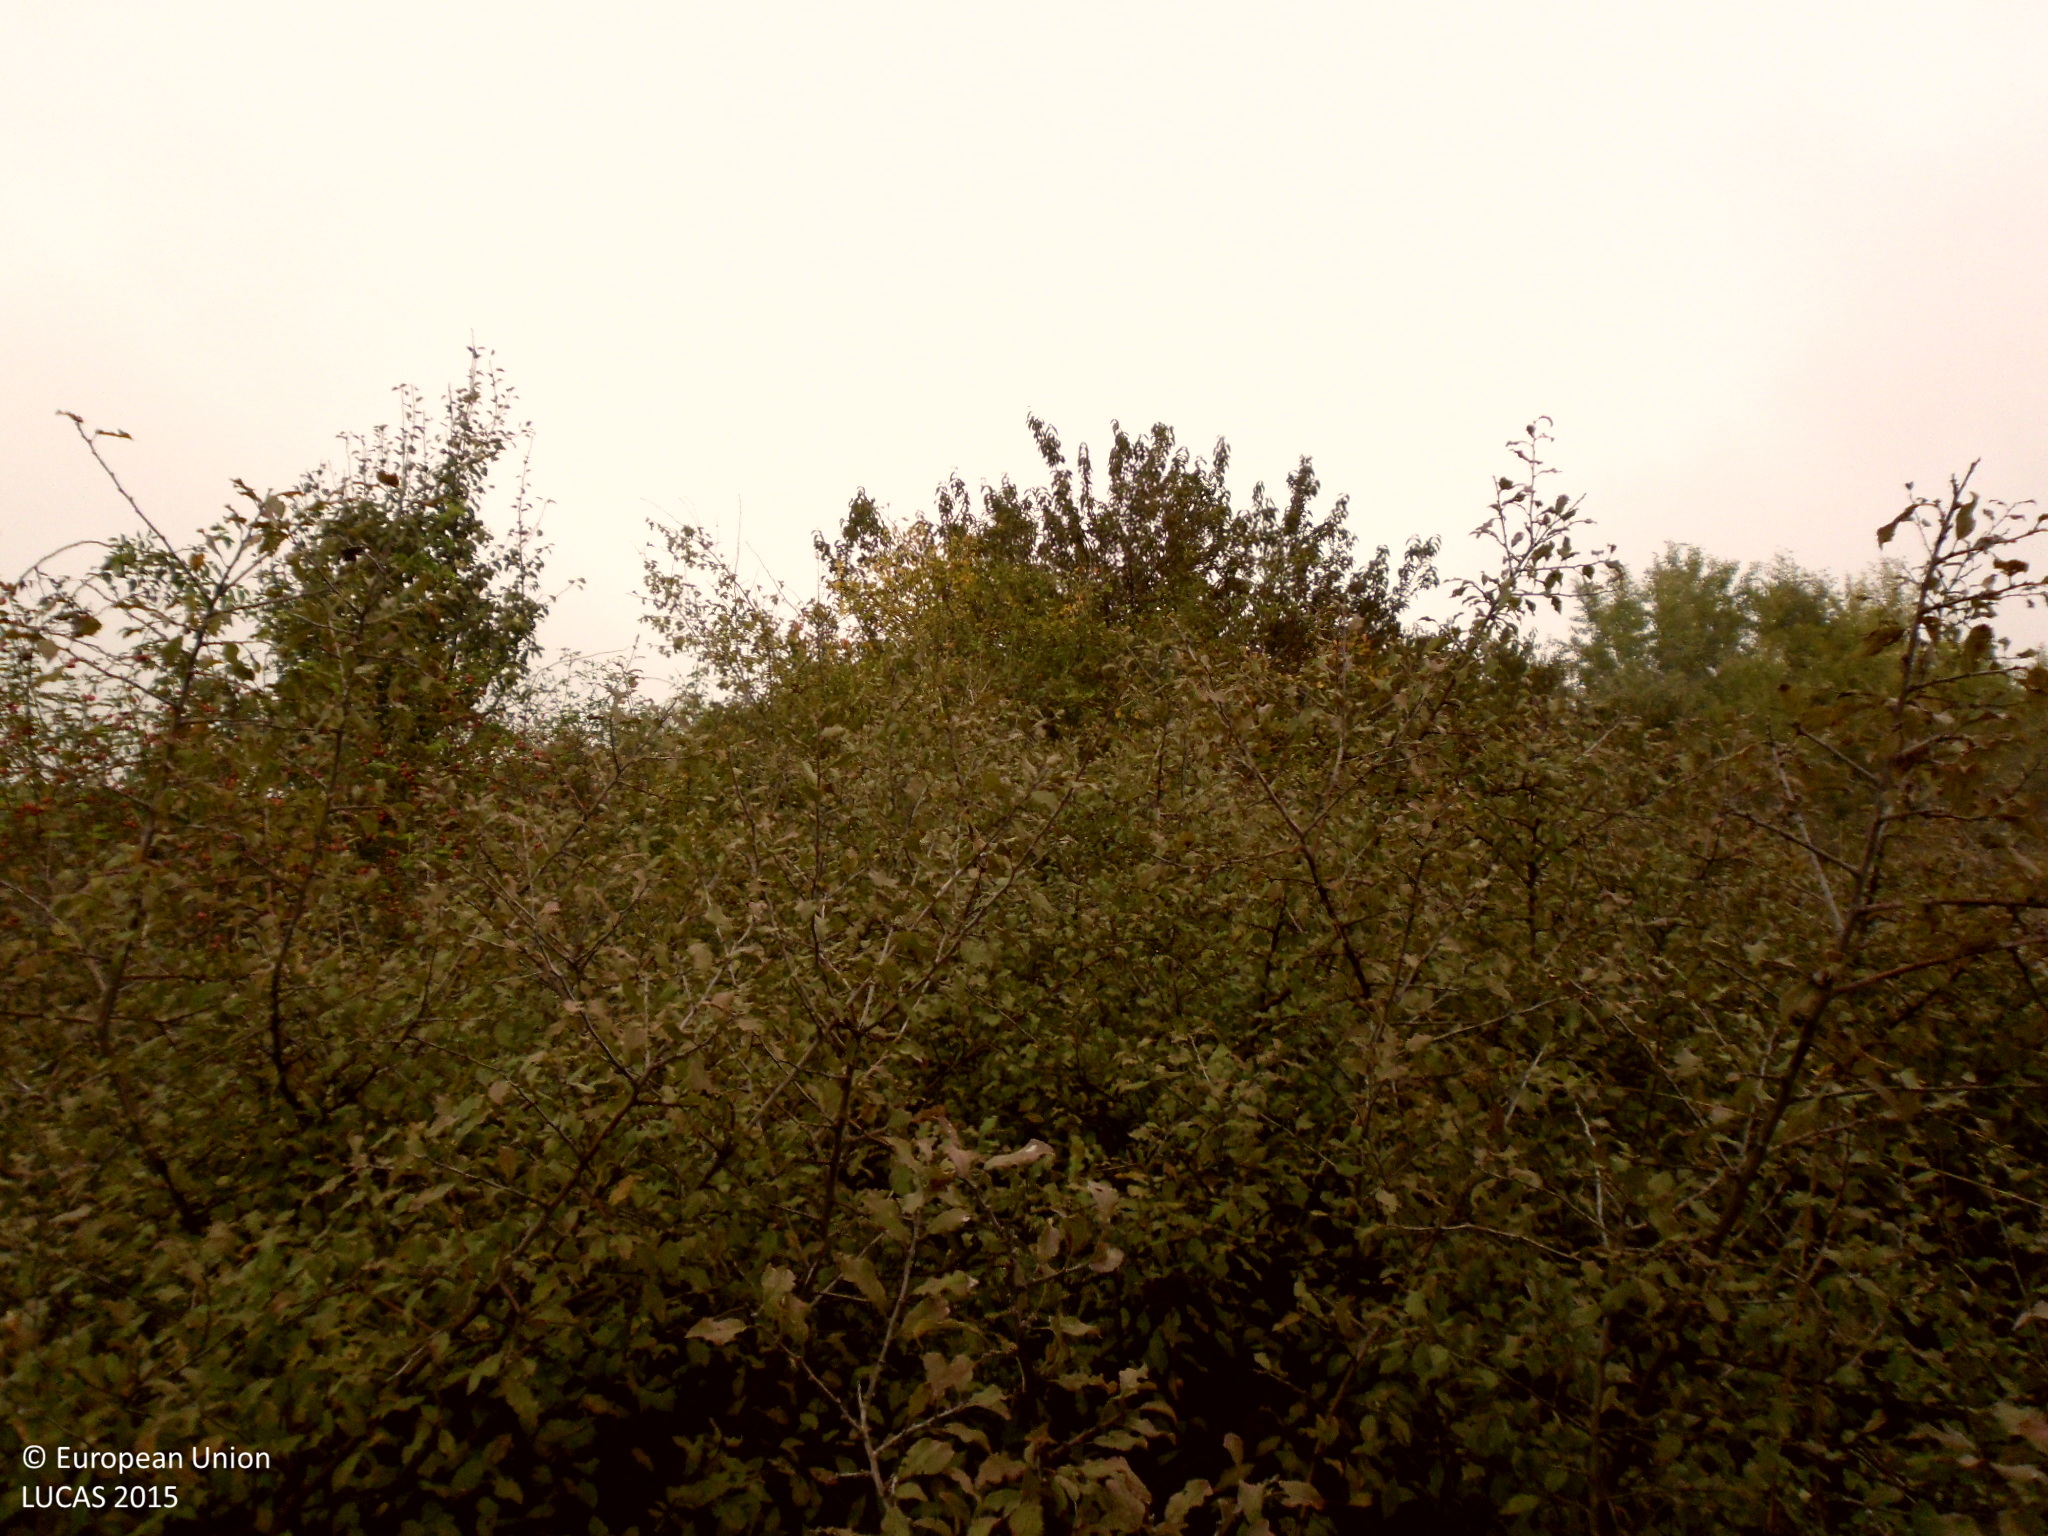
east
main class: Shrubland
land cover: Shrubland with sparse tree cover
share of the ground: > 75 %
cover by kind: shrubs 95 %, broadleaved forest trees 5 %
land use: Semi-natural and natural areas not in use
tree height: < 5 m
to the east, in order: Shrubland with sparse tree cover; Grass margins; Common wheat; Grassland with sparse tree/shrub cover
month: October
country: BG
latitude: 43.9223
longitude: 22.6272
